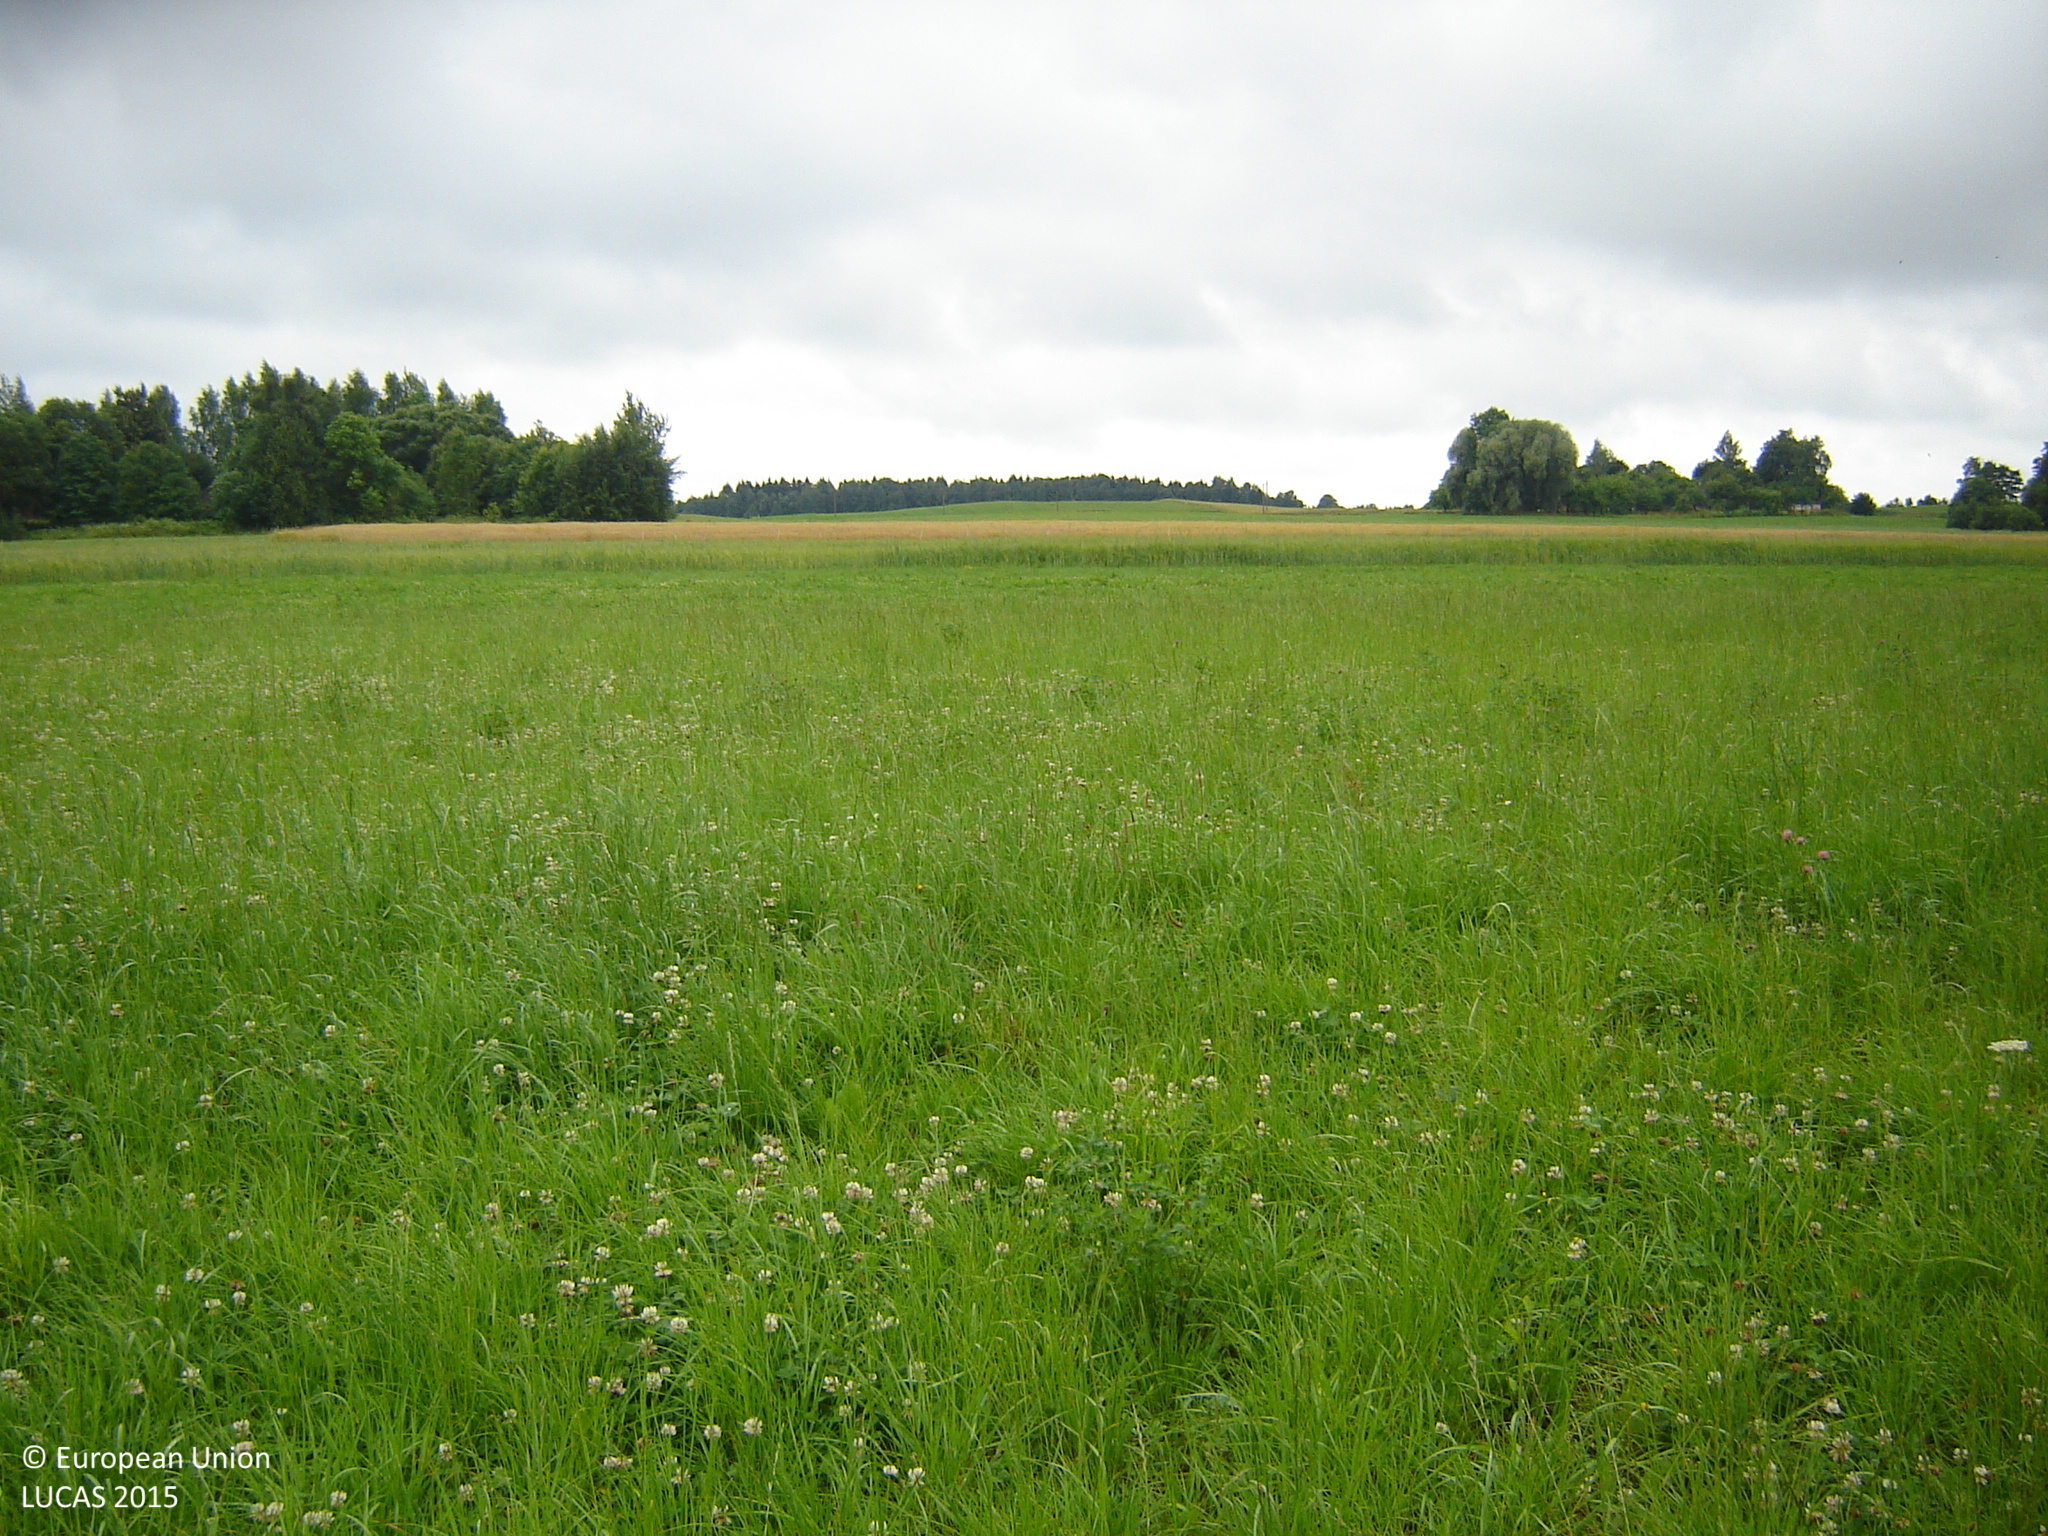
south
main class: Grassland
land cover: Grassland without tree/shrub cover
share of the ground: > 75 %
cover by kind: herbaceous plants 100 %
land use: Agriculture (excluding fallow land and kitchen gardens)
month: July
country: LT
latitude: 55.3467
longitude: 25.2088
